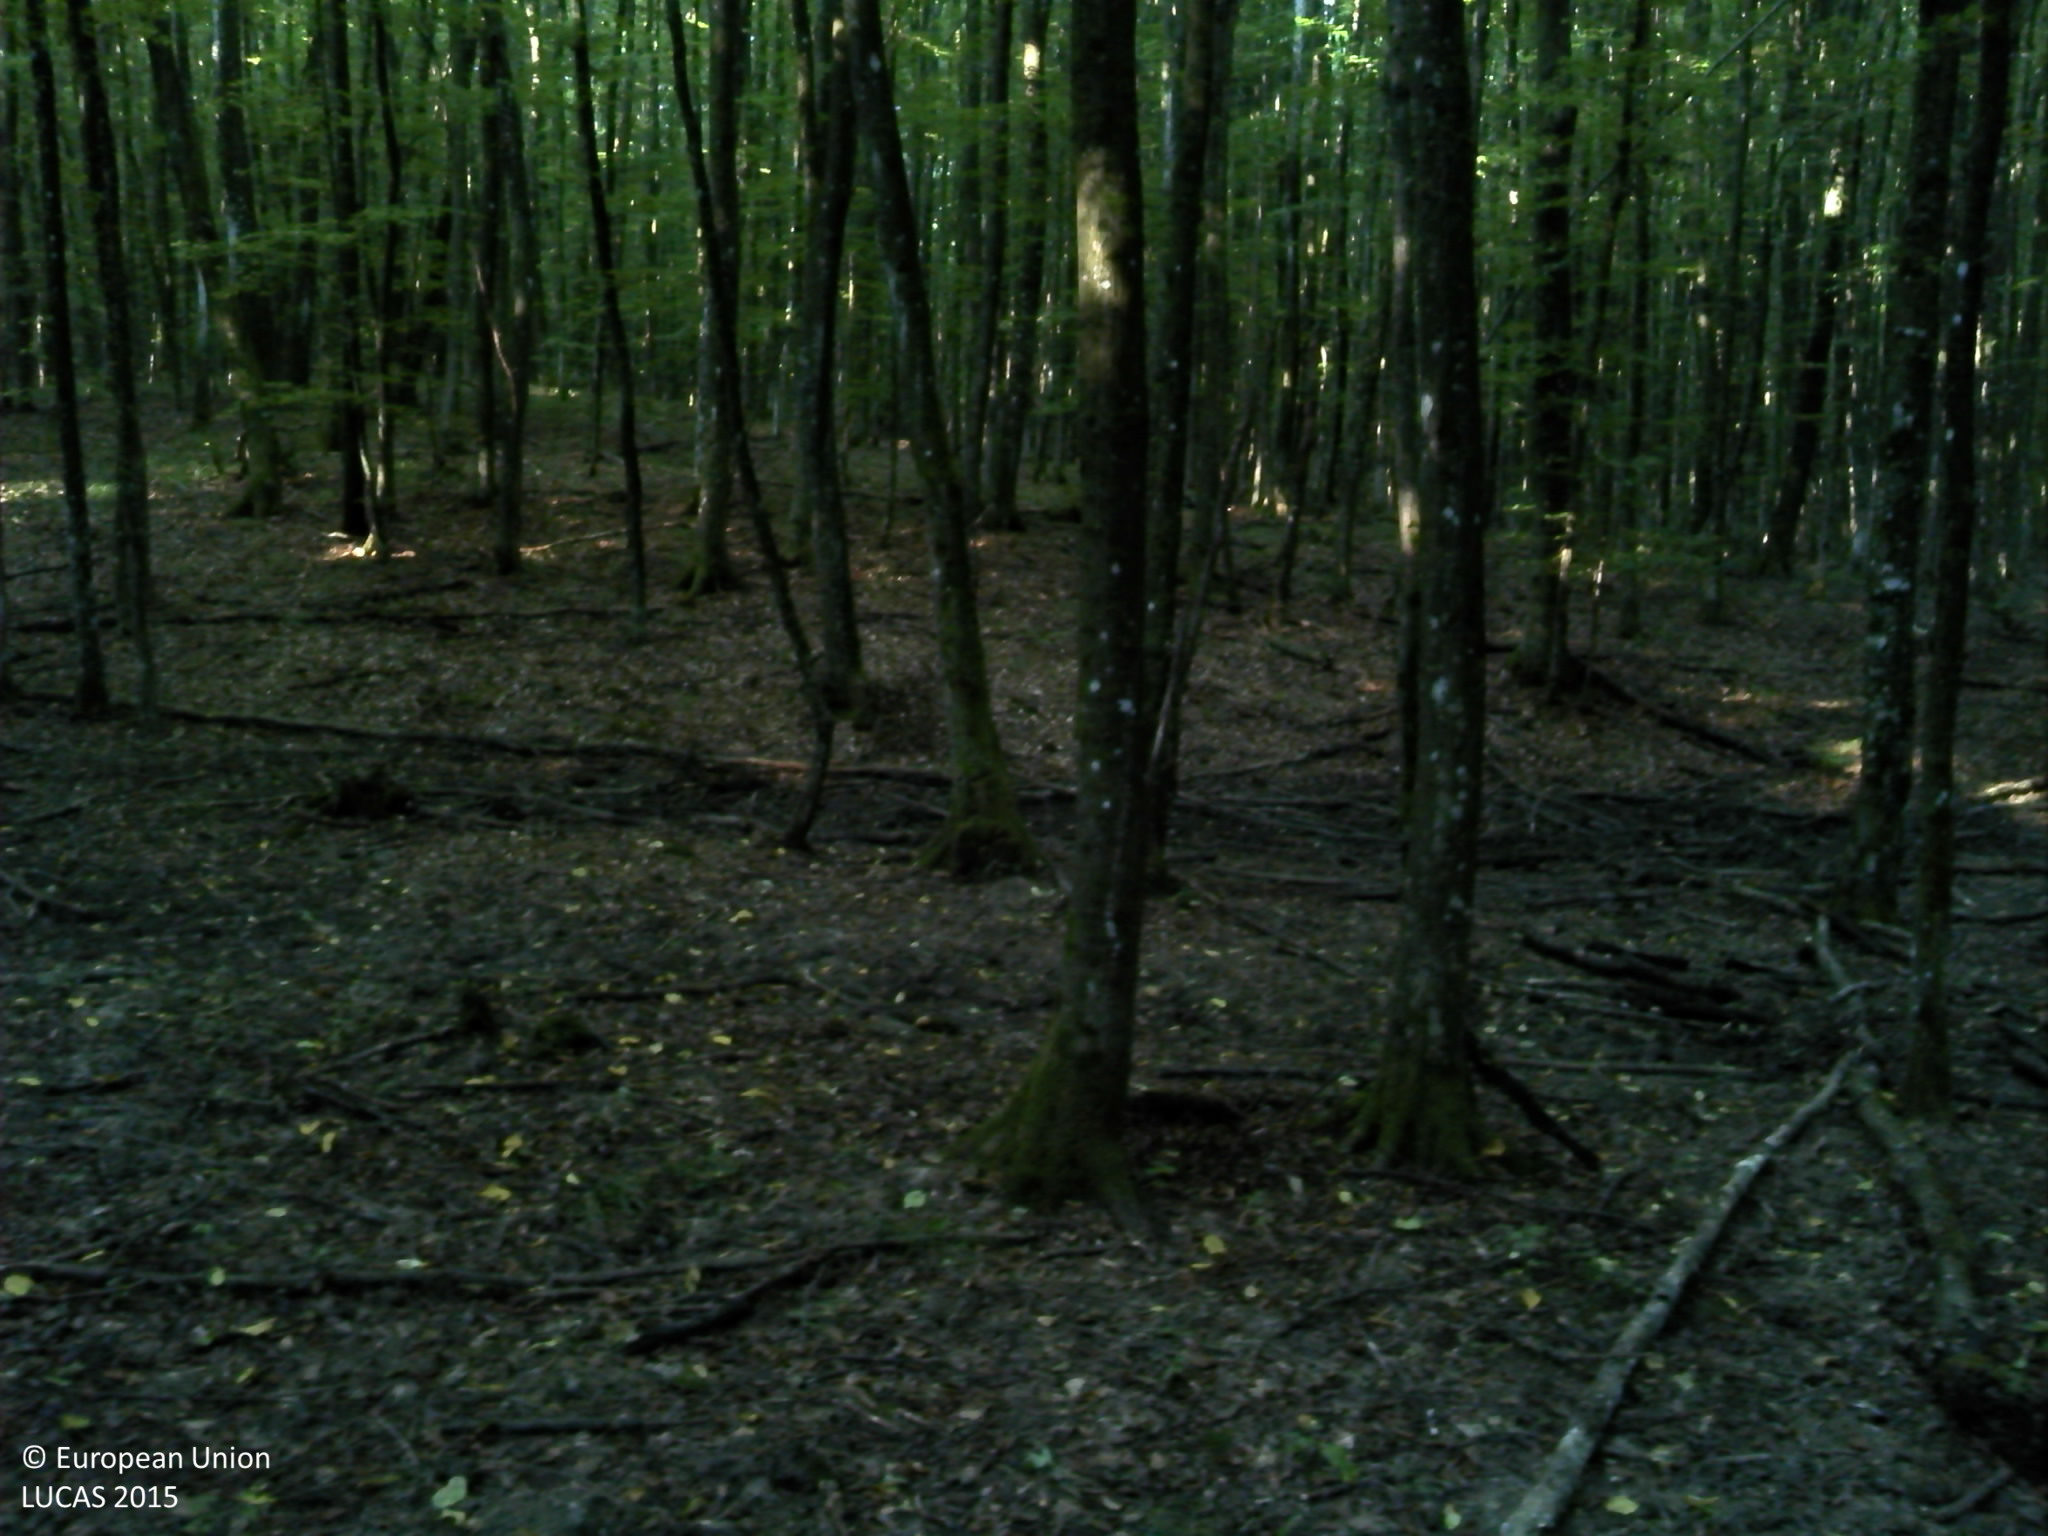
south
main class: Woodland
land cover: Broadleaved woodland
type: beech forest
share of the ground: > 75 %
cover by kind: broadleaved forest trees 100 %
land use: Forestry
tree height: > 5 m
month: August
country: HR
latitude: 45.7048
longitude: 17.2841
